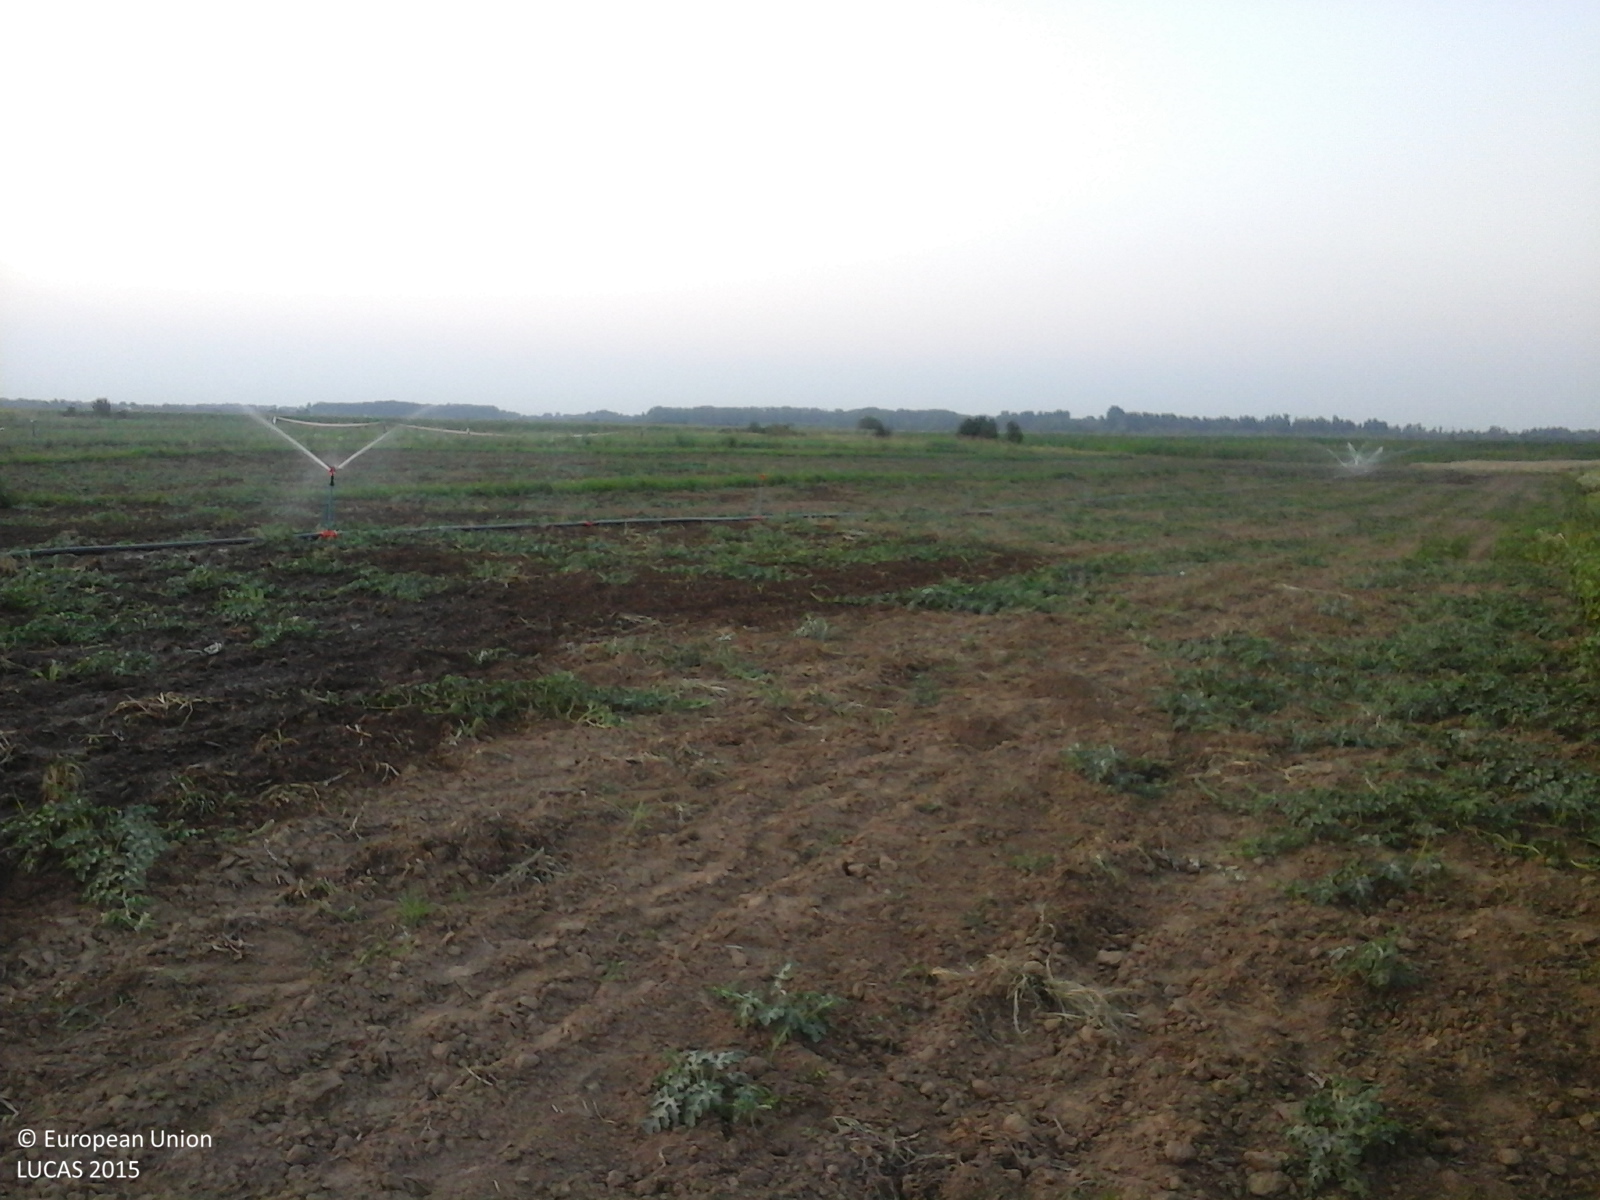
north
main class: Cropland
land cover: Other fresh vegetables
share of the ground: 50 - 75 %
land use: Agriculture (excluding fallow land and kitchen gardens)
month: July
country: RO
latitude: 44.5508
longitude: 25.5128
